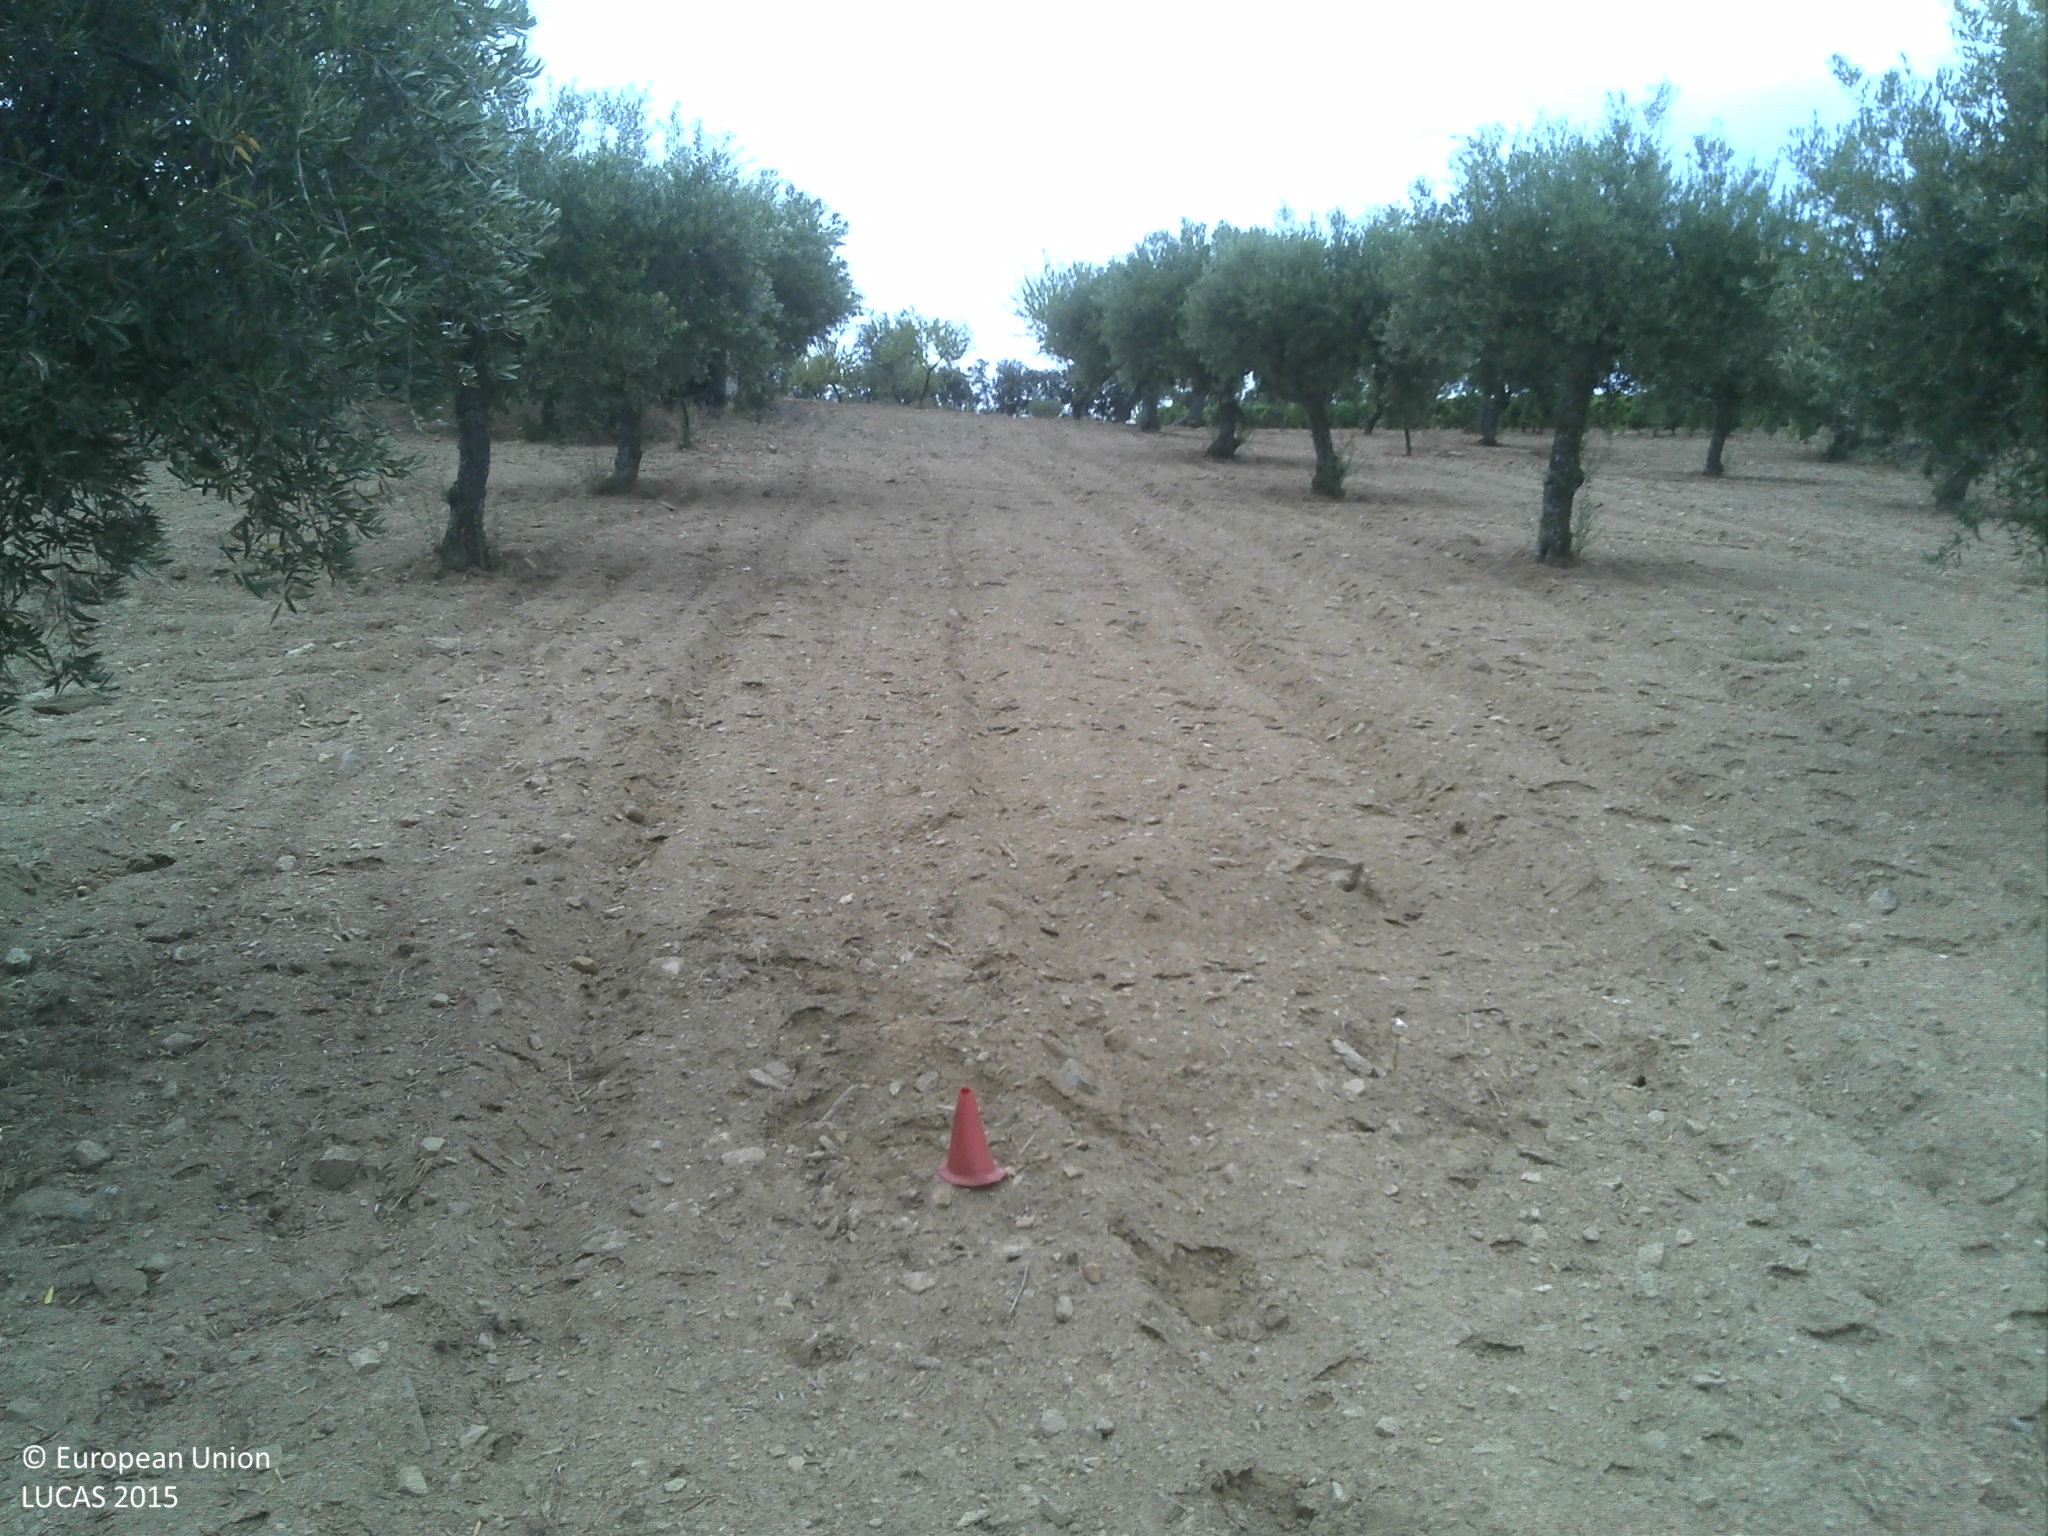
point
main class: Cropland
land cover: Olive groves
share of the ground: < 10 %
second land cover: Other bare soil
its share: > 75 %
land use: Agriculture (excluding fallow land and kitchen gardens)
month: July
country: PT
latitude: 41.0488
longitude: -7.2579
